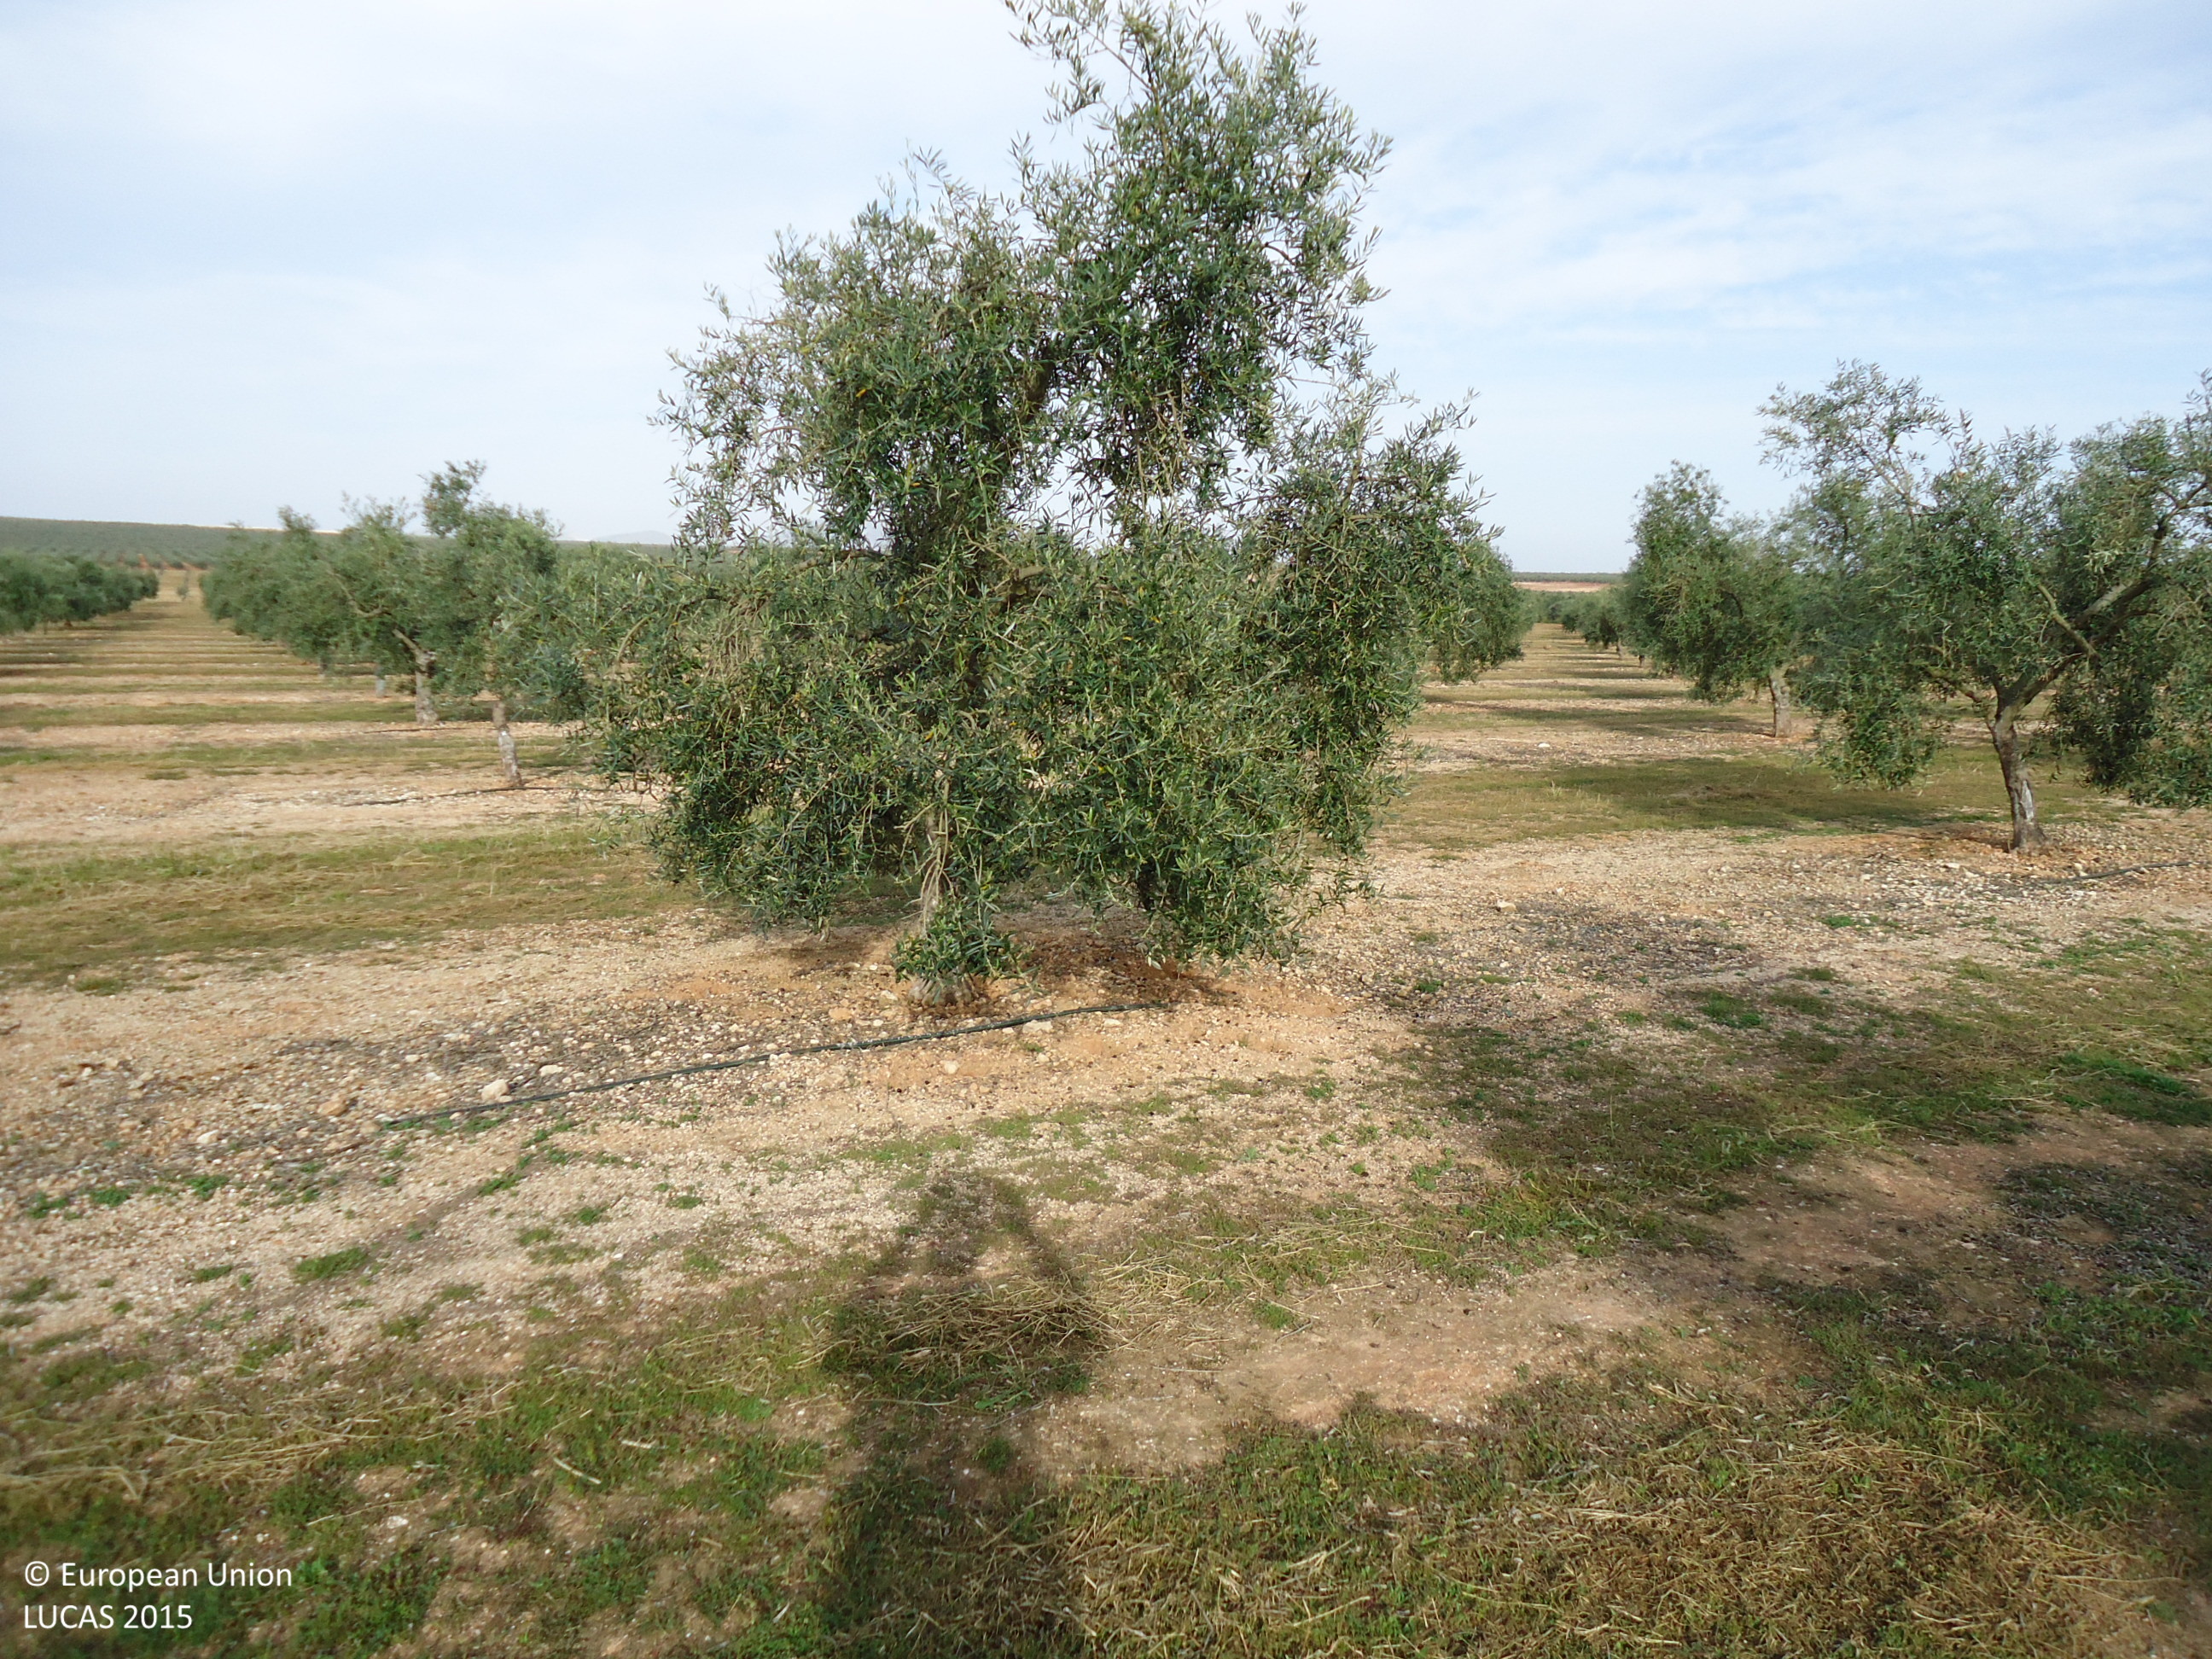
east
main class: Cropland
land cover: Olive groves
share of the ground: 10 - 25 %
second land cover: Spontaneously vegetated surfaces
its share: 10 - 25 %
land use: Agriculture (excluding fallow land and kitchen gardens)
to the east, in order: Olive groves; Spontaneously vegetated surfaces
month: April
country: ES
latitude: 37.1516
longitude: -4.8082
